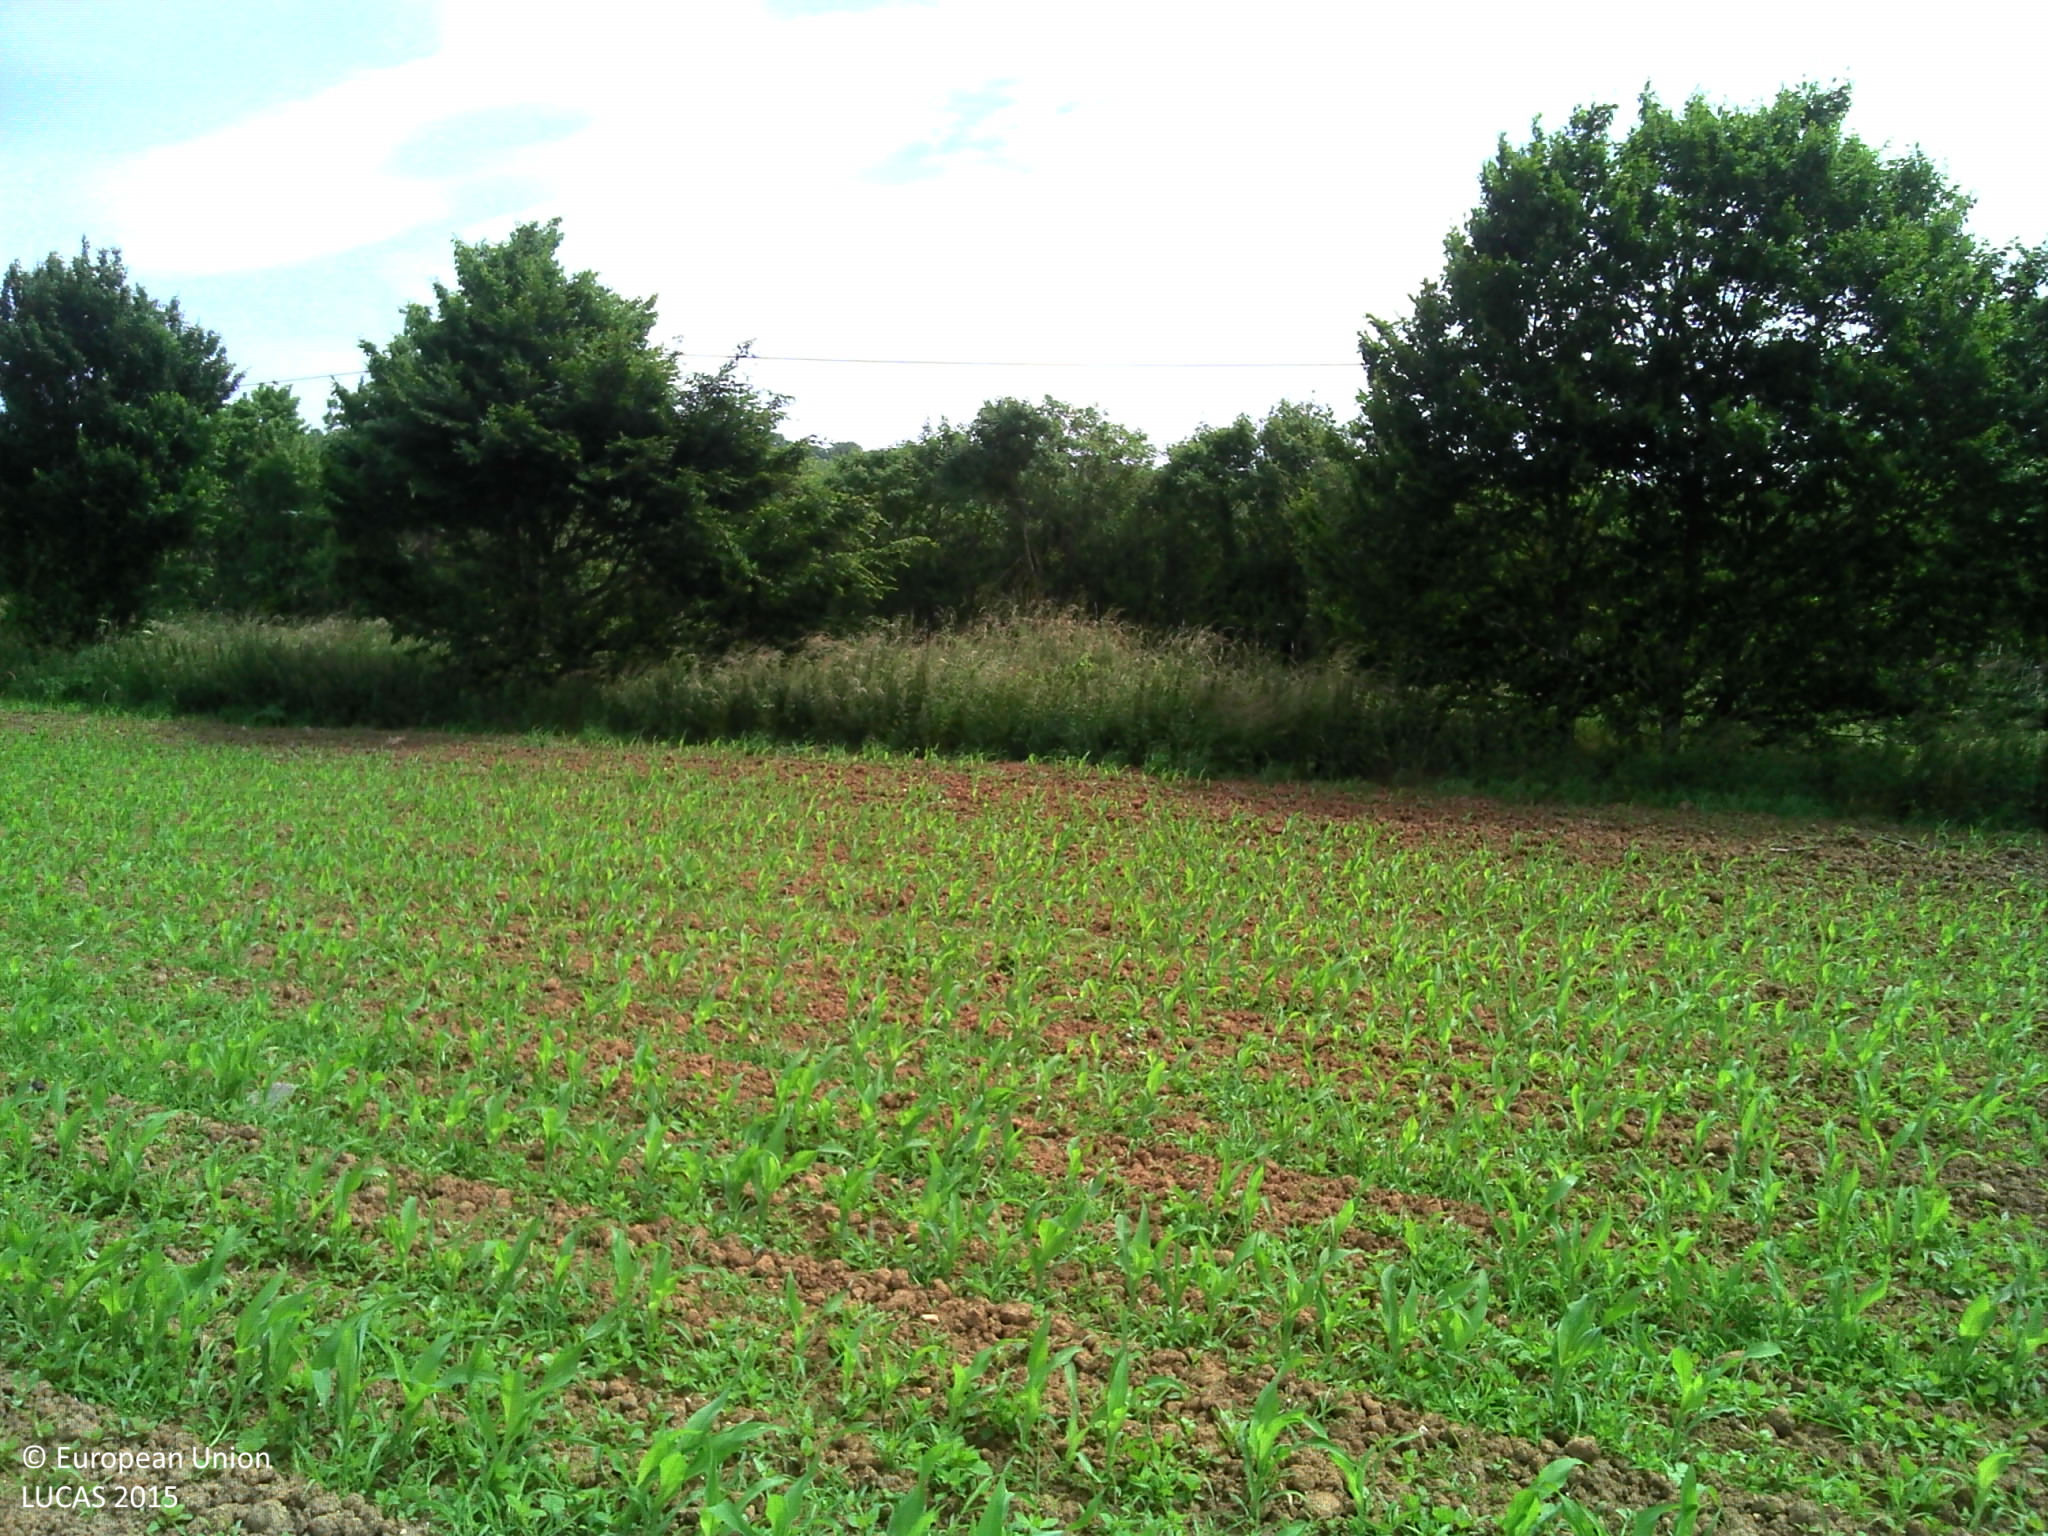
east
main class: Cropland
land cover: Maize
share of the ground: 10 - 25 %
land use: Agriculture (excluding fallow land and kitchen gardens)
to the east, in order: Maize; Ditches and canals; Managed hedges; Grass margins; Paved roads, cycling and walking lanes; Grass margins; Ditches and canals; Managed hedges; Fences; Grassland without tree/shrub cover; Fences; Tracks; Grassland without tree/shrub cover; Broadleaved woodland; Grassland without tree/shrub cover; Broadleaved woodland; Grassland without tree/shrub cover
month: June
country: FR
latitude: 49.1635
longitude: -0.0010
